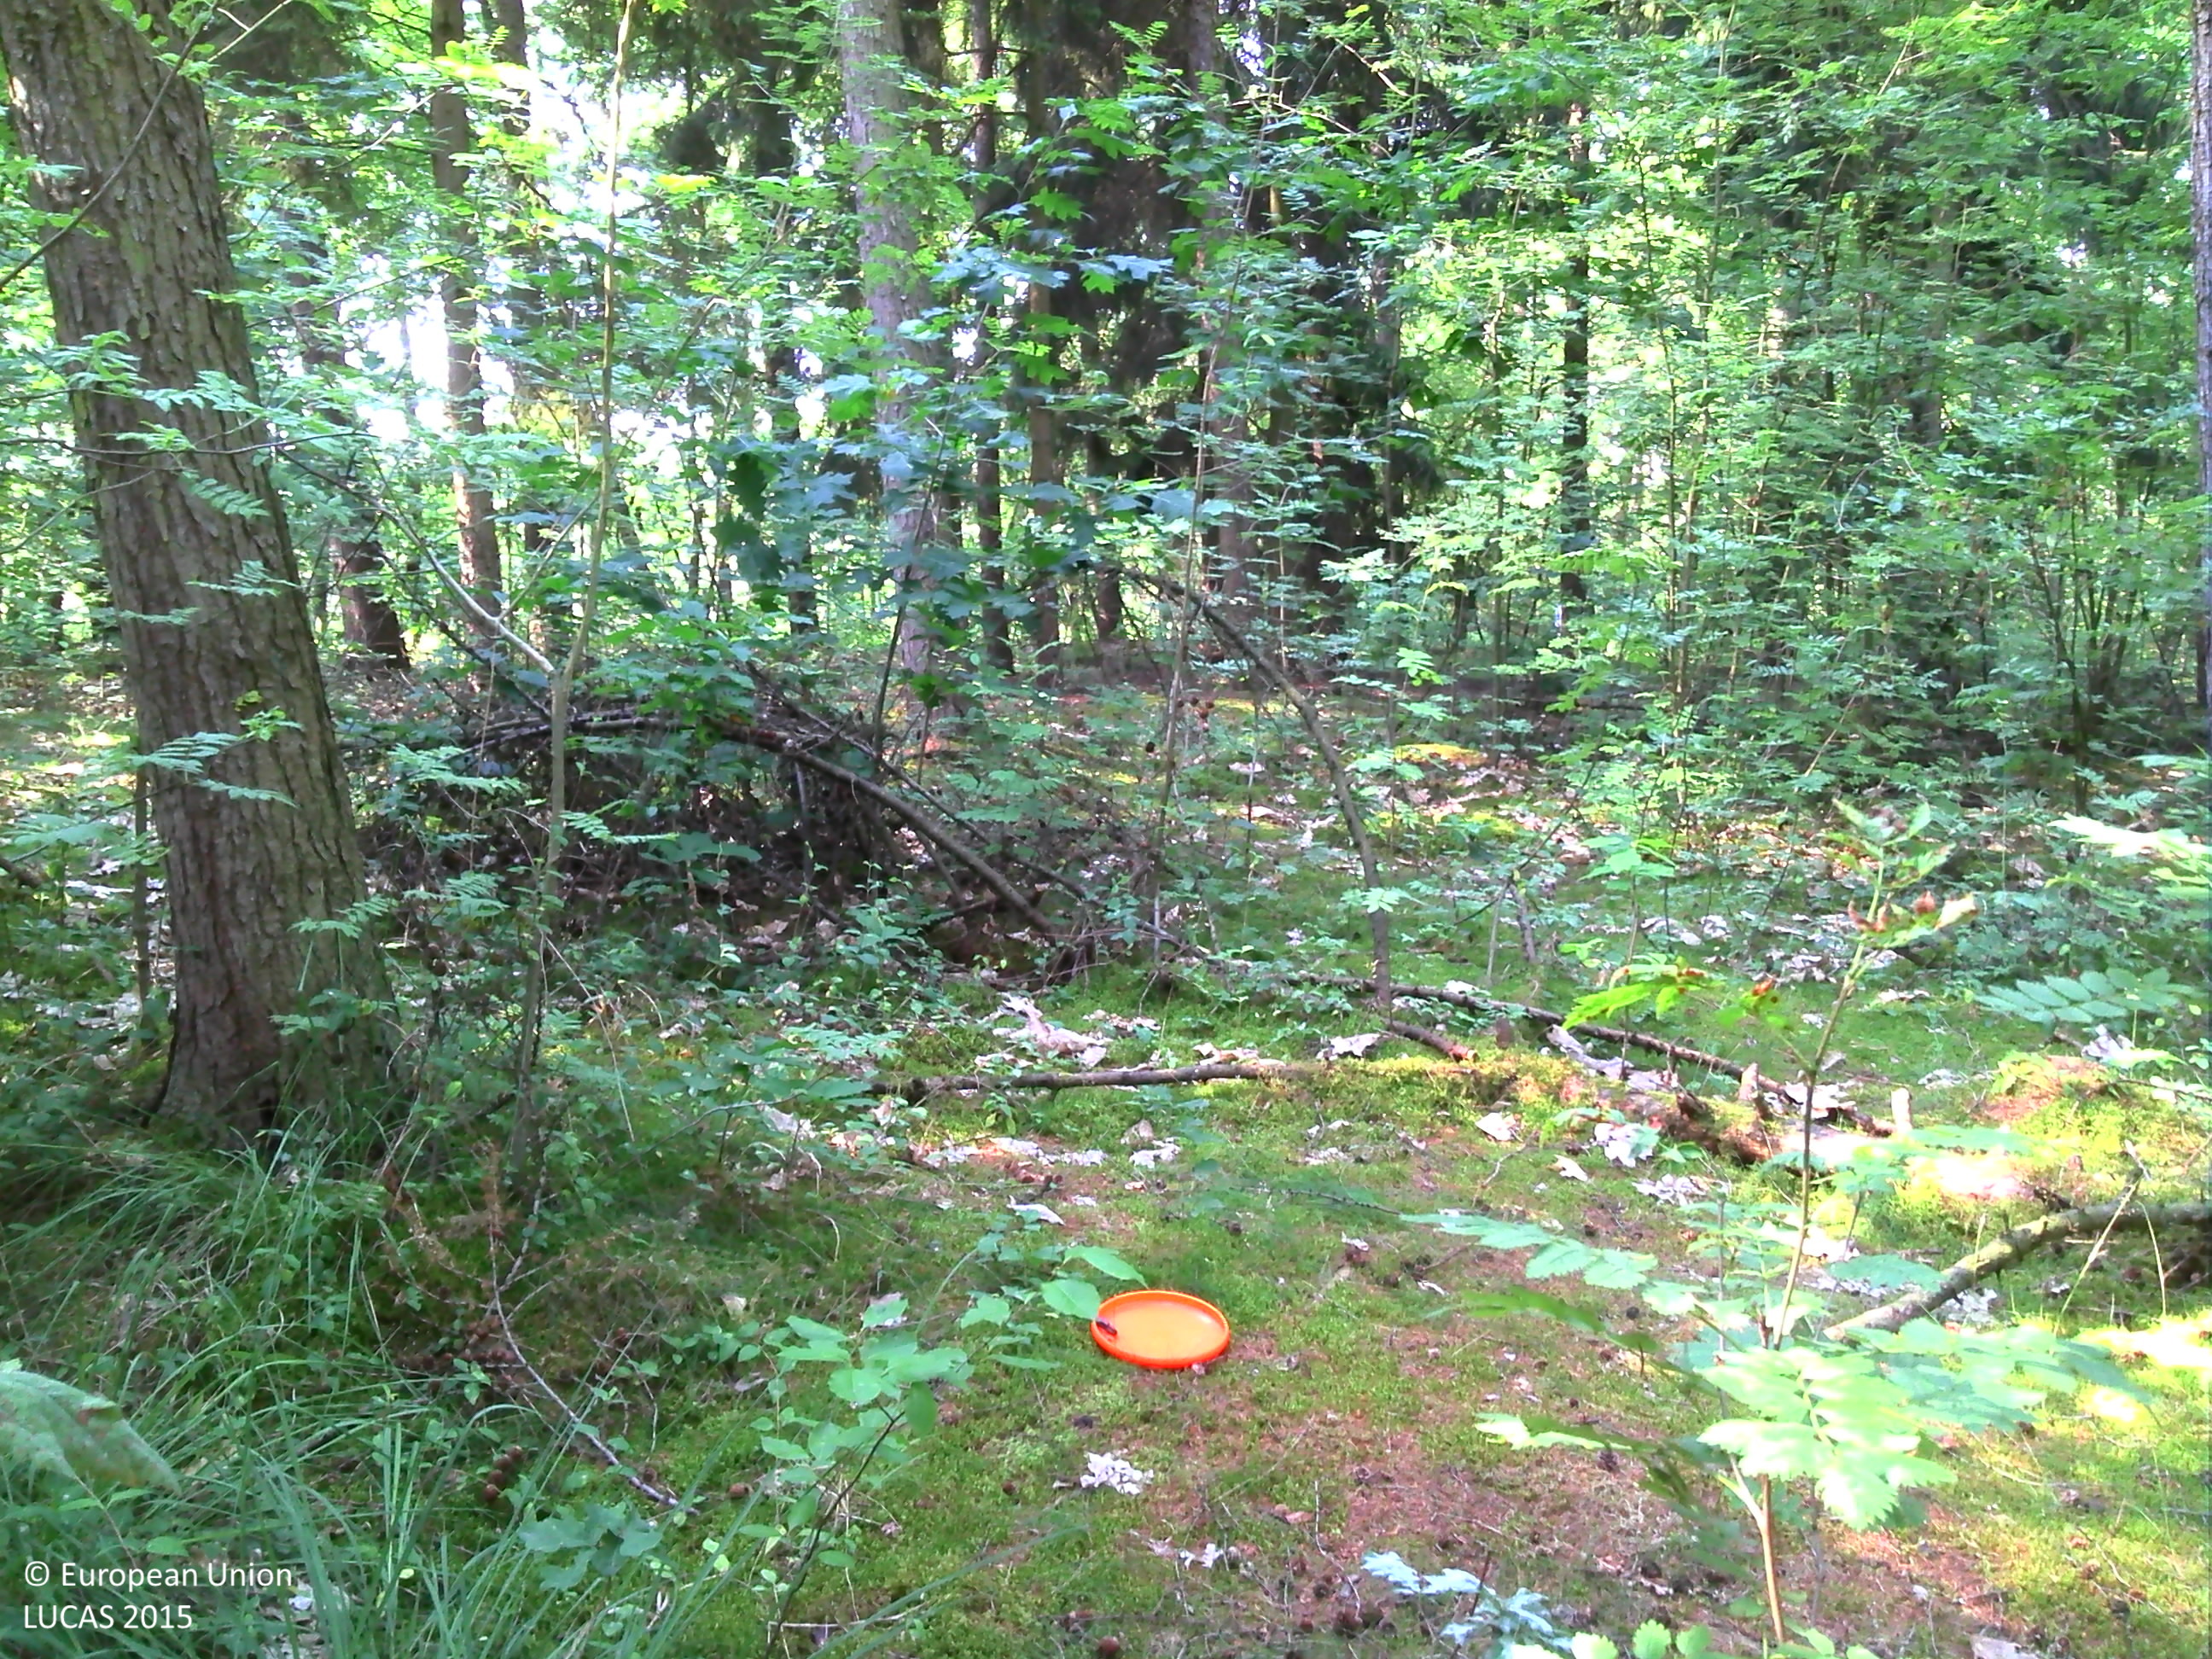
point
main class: Woodland
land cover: Other mixed woodland
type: exotic forest
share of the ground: > 75 %
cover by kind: coniferous forest trees 70 %, broadleaved forest trees 25 %, lichens and mosses 5 %
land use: Forestry
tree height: > 5 m
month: July
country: BE
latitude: 50.9750
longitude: 5.4263
